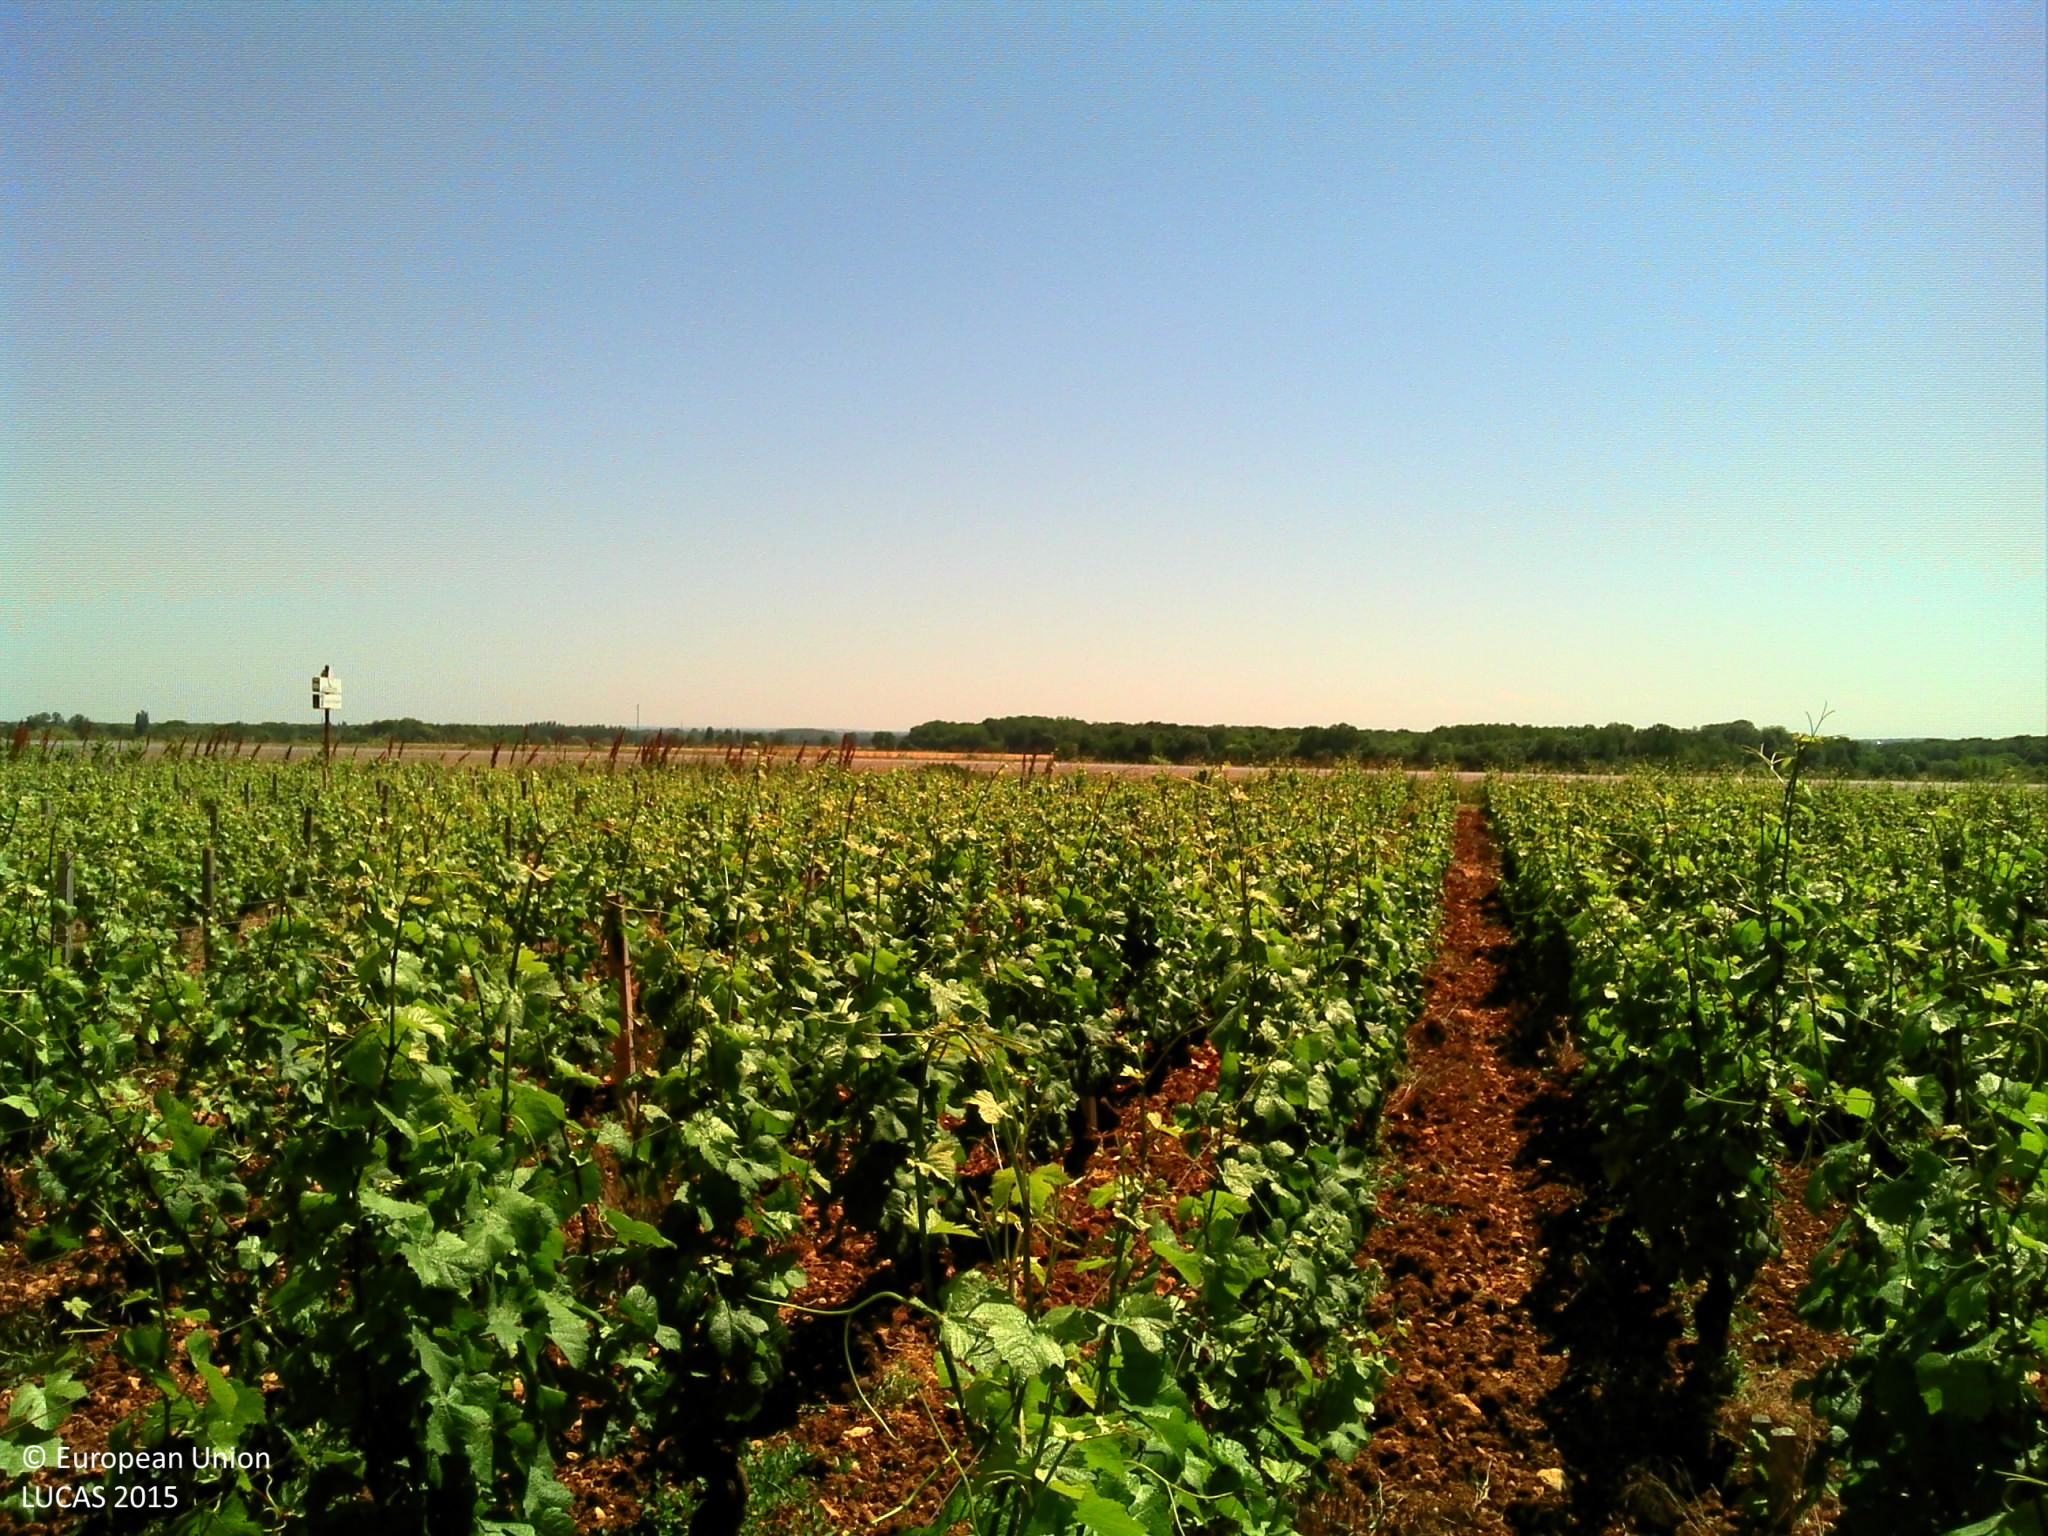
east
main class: Cropland
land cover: Vineyards
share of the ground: 50 - 75 %
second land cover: Other bare soil
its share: > 75 %
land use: Agriculture (excluding fallow land and kitchen gardens)
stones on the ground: > 50 %
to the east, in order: Vineyards; Other bare soil; Tracks; Ditches and canals; Grass margins; Paved roads, cycling and walking lanes; Grass margins; Tracks; Vineyards; Tracks; Vineyards
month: June
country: FR
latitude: 47.2071
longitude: 4.9706
